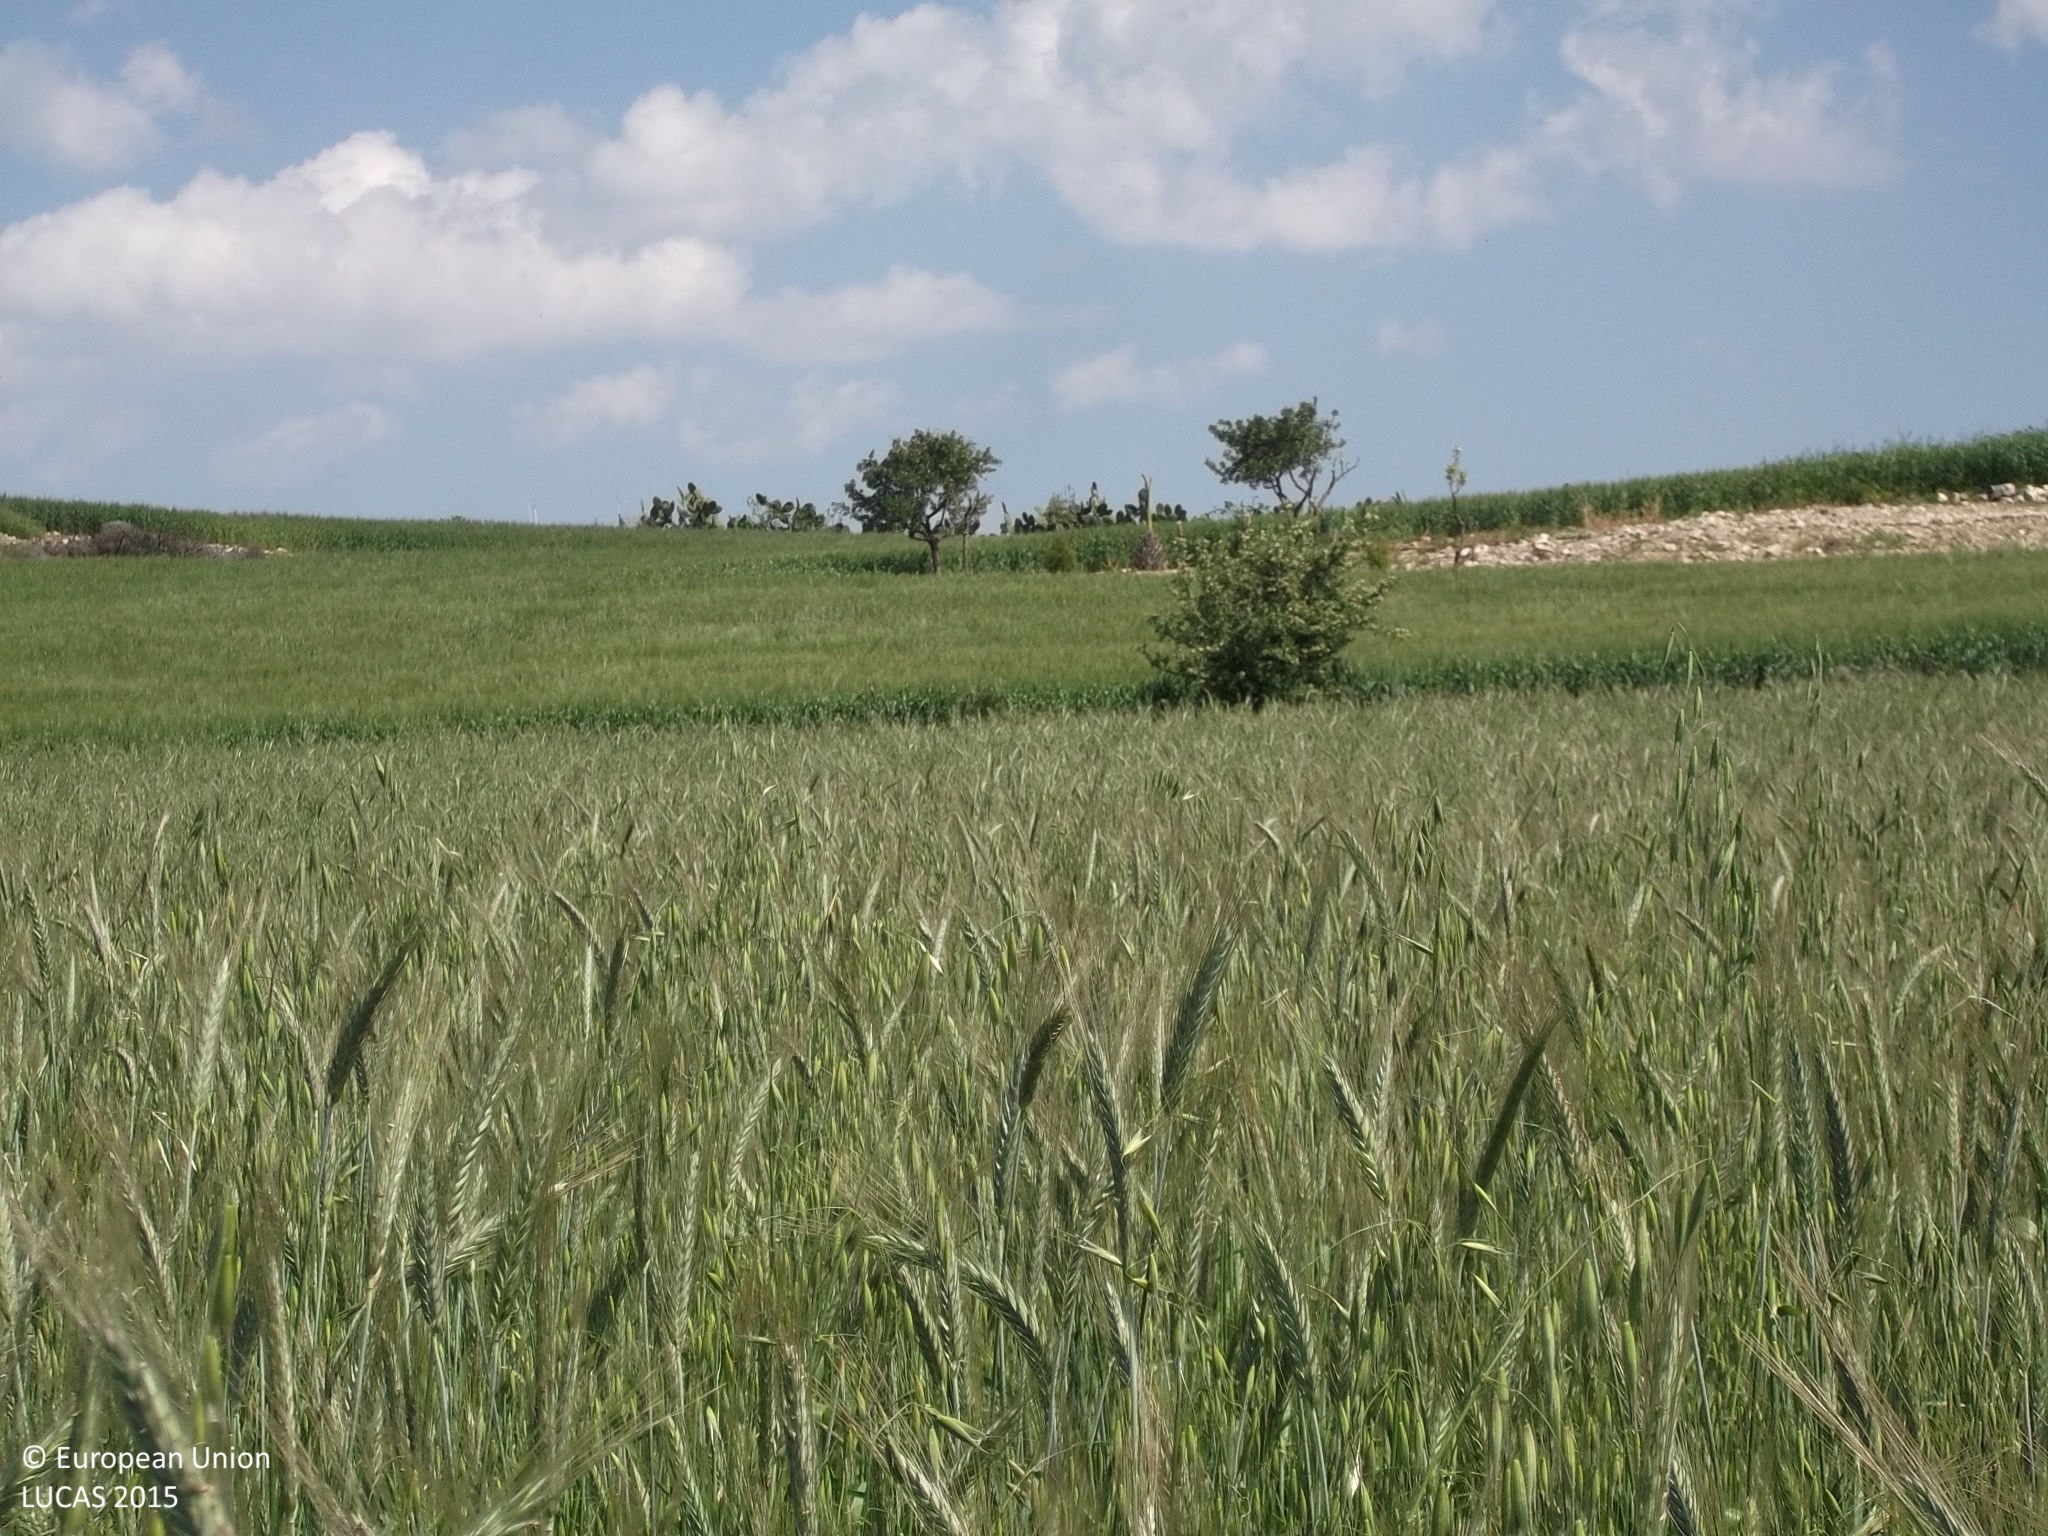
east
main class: Cropland
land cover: Common wheat
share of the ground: > 75 %
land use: Agriculture (excluding fallow land and kitchen gardens)
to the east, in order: Common wheat; Mixed cereals for fodder; Grassland with sparse tree/shrub cover; Tracks; Spontaneously vegetated surfaces; Tracks; Mixed cereals for fodder
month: April
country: CY
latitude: 34.8997
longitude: 33.5342
